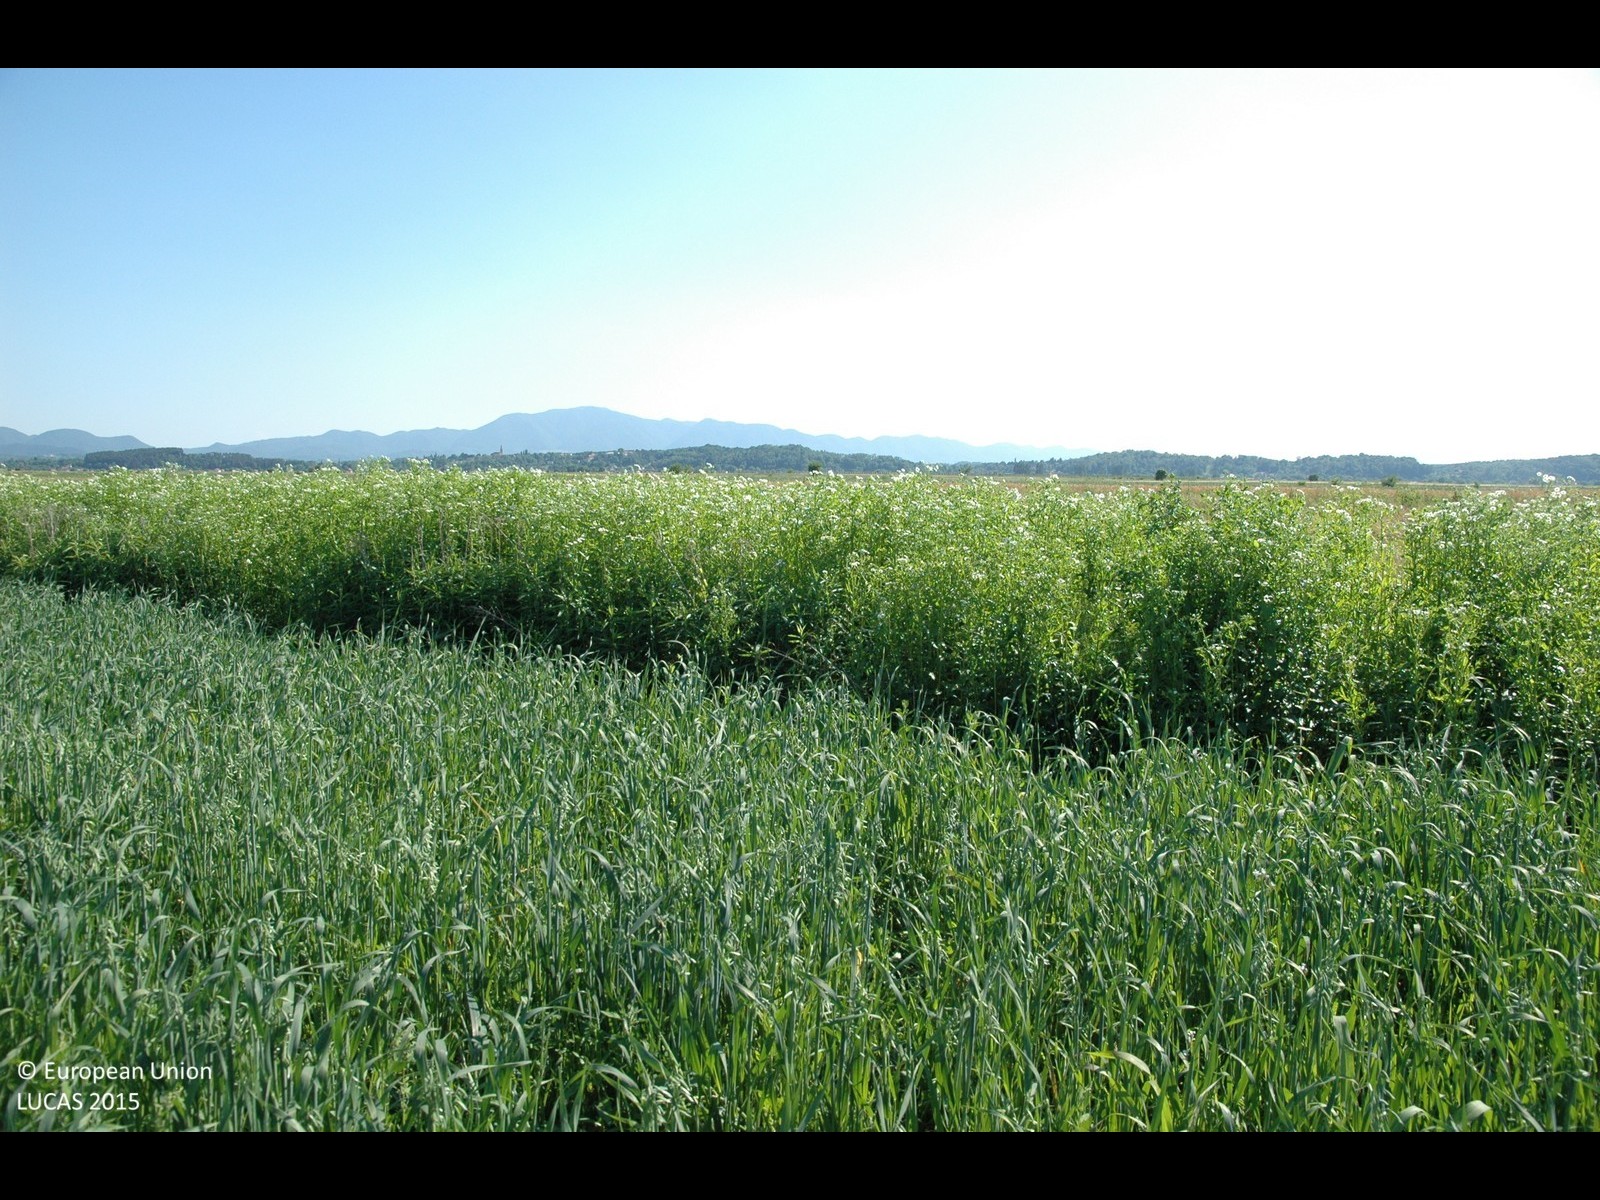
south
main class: Cropland
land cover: Oats
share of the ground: > 75 %
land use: Agriculture (excluding fallow land and kitchen gardens)
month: June
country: HR
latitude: 46.3162
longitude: 16.1944
